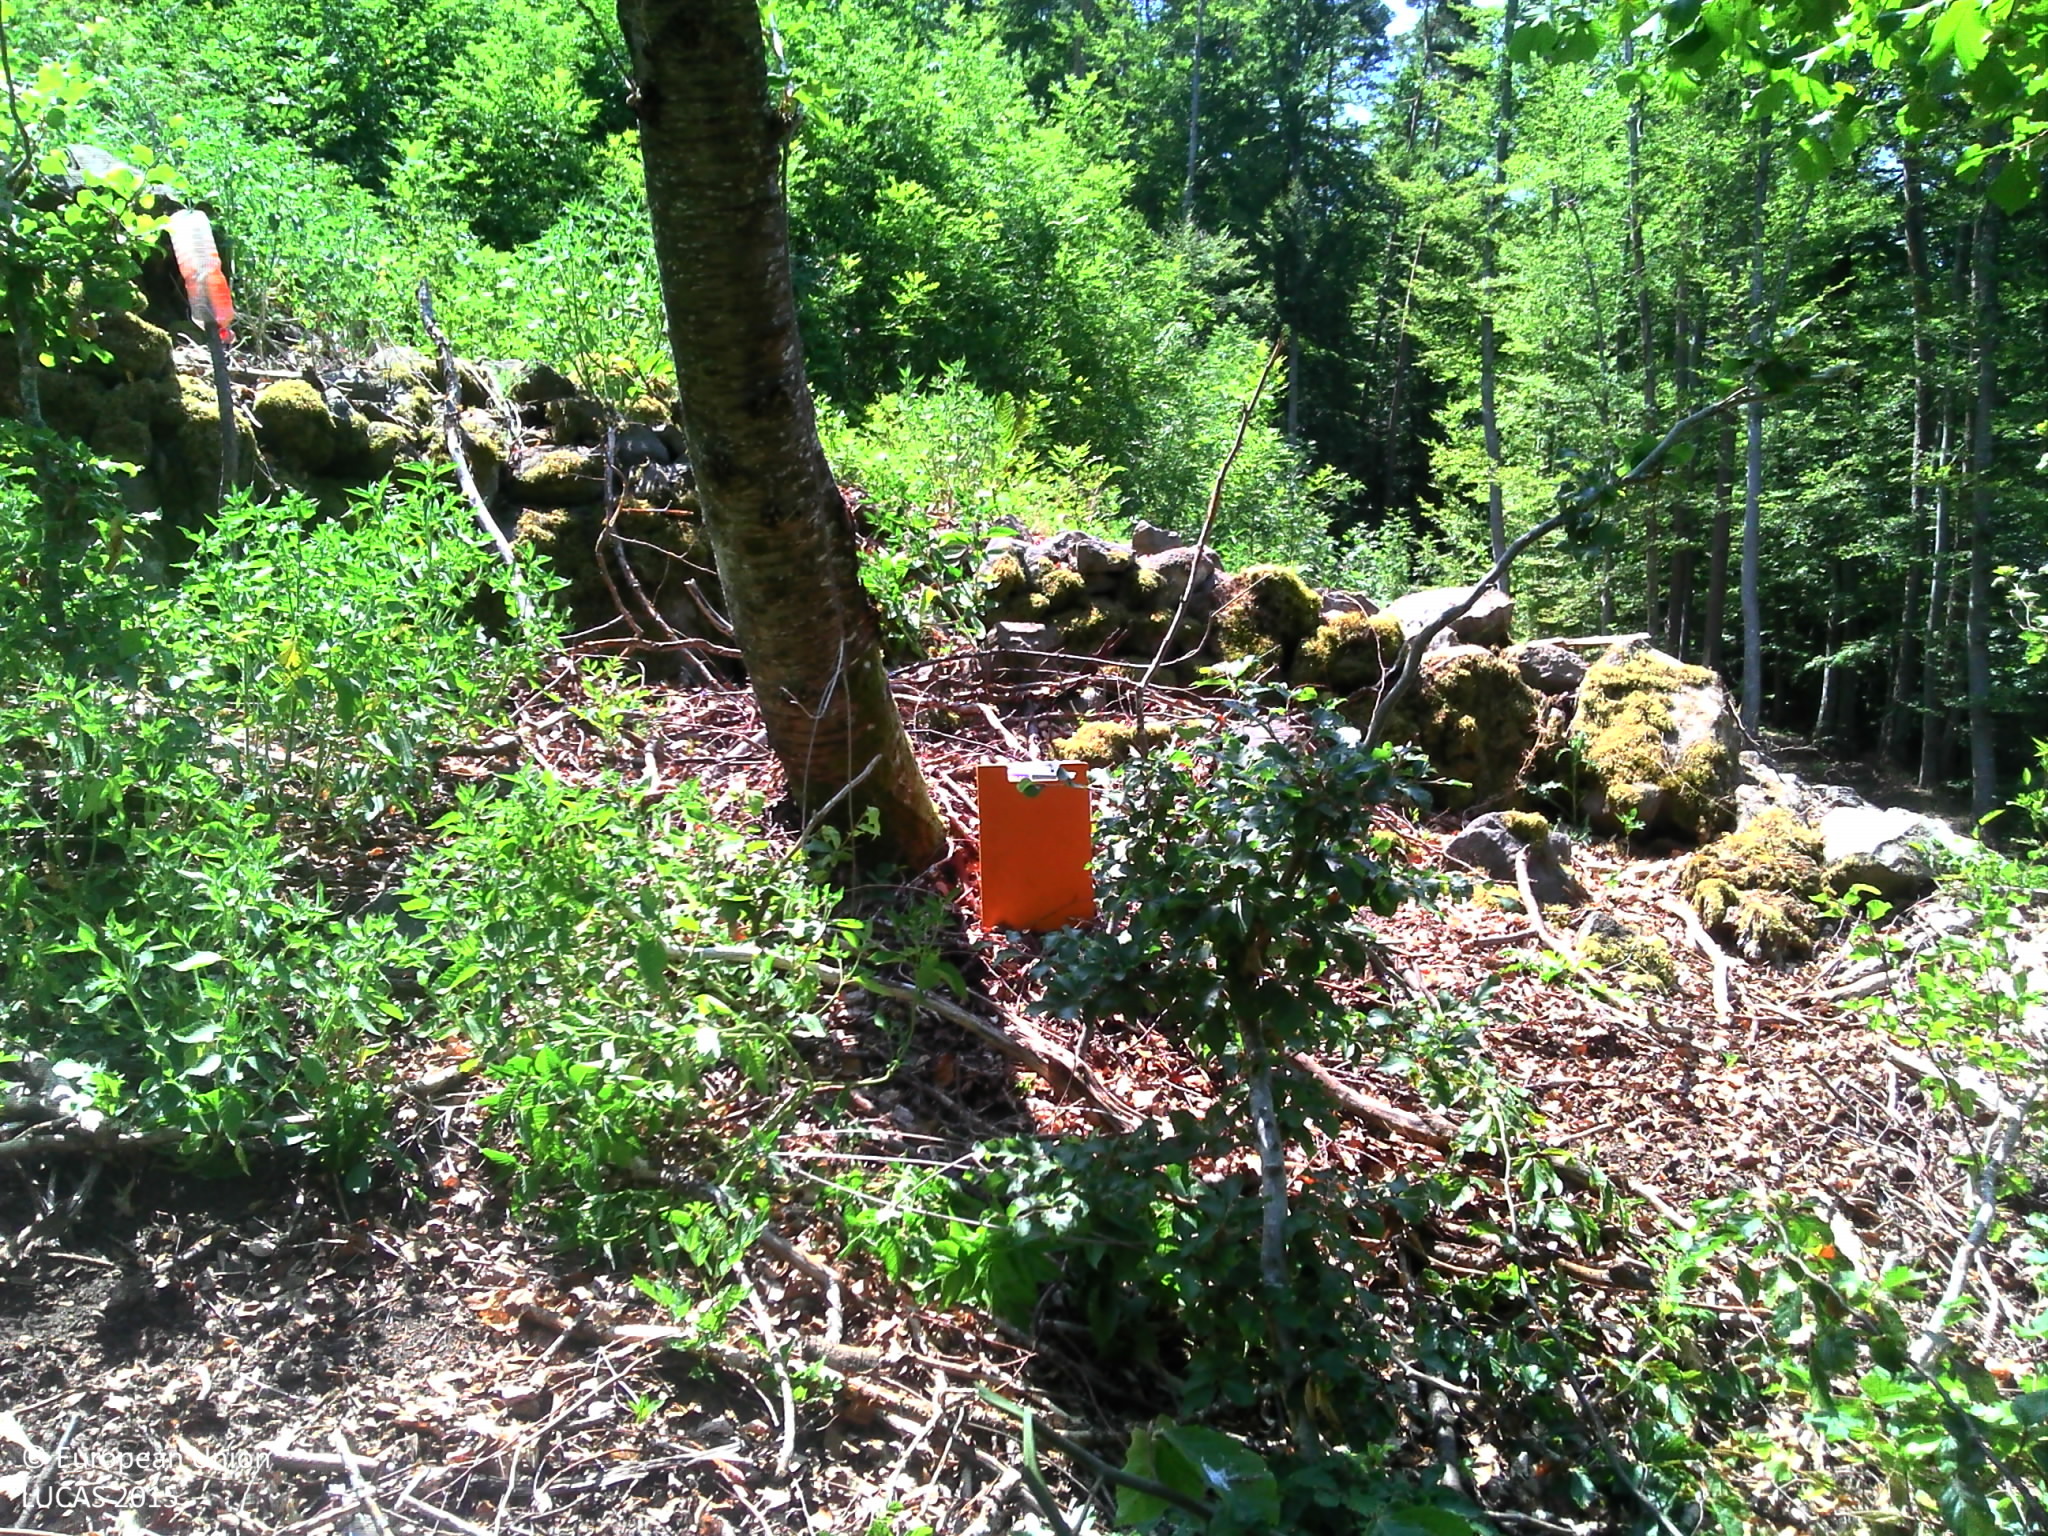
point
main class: Shrubland
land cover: Shrubland with sparse tree cover
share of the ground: > 75 %
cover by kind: shrubs 60 %, unconsolidated bare surface 20 %, herbaceous plants 15 %, broadleaved forest trees 5 %
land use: Forestry
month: July
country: FR
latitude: 45.1022
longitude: 2.8974
